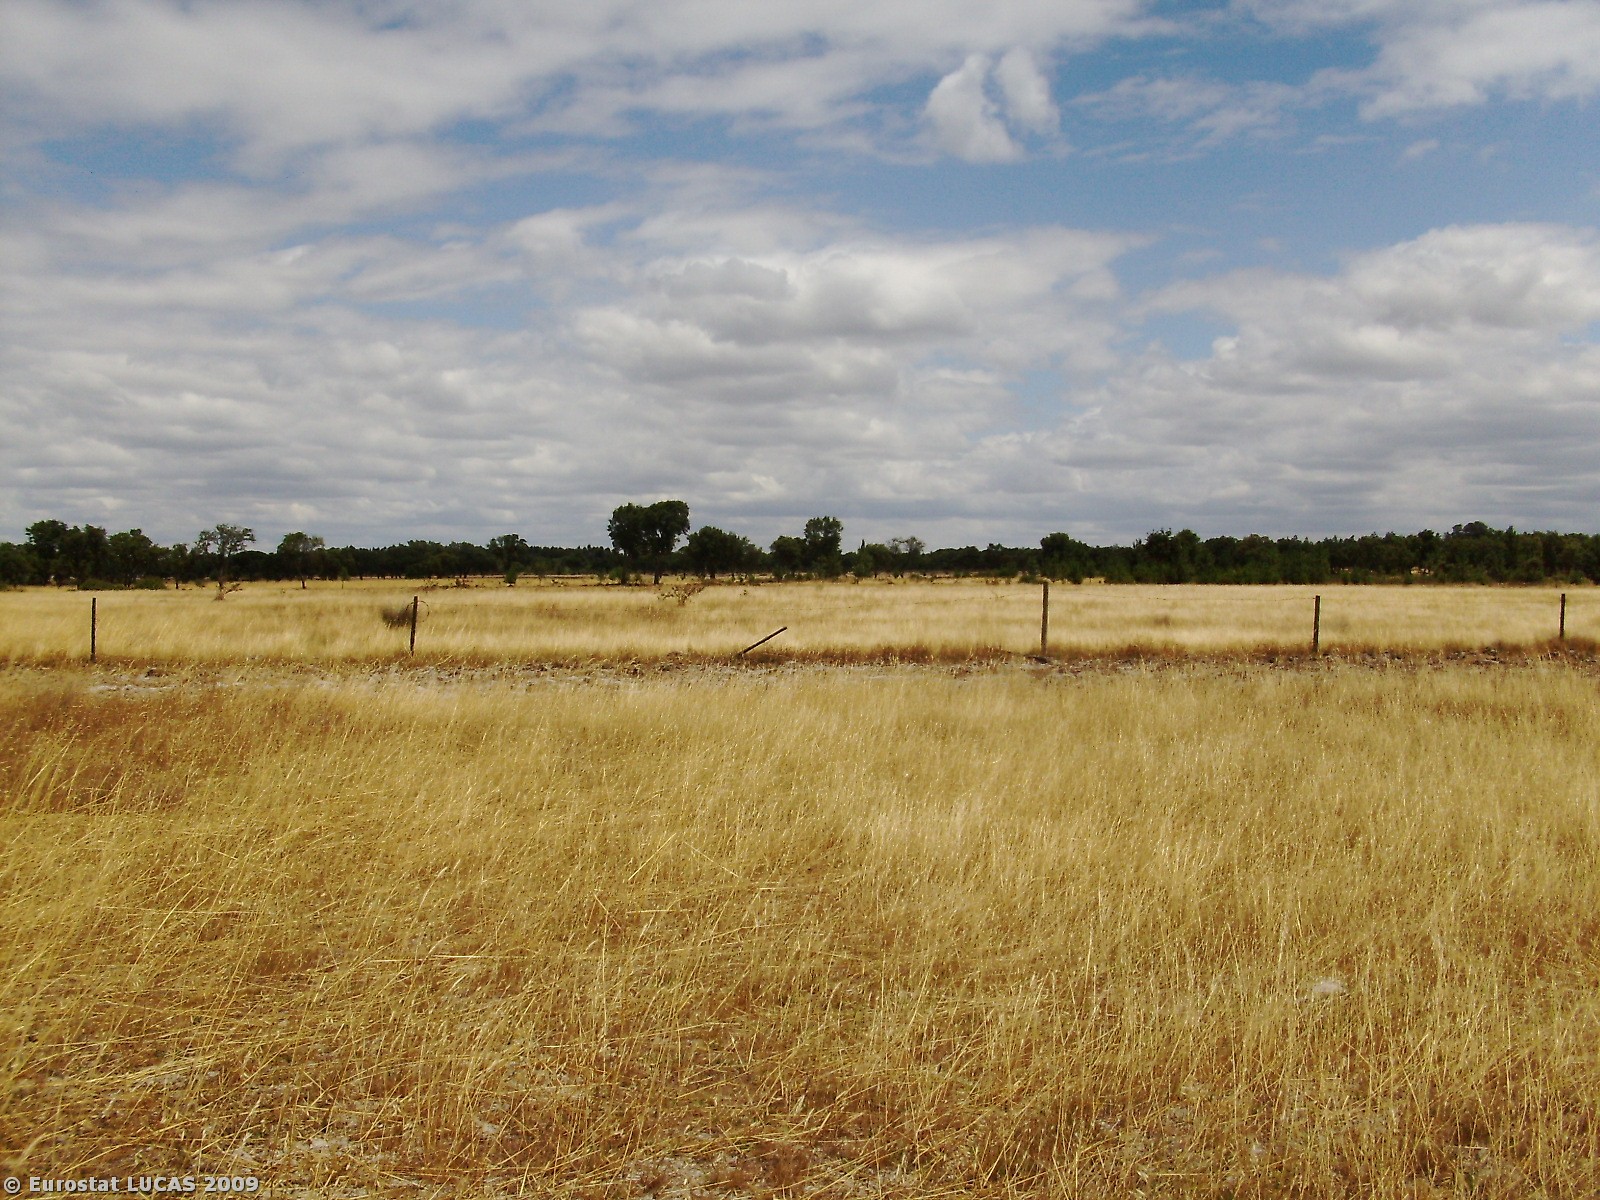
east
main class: Grassland
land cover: Grassland without tree/shrub cover
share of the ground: > 75 %
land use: Agriculture (excluding fallow land and kitchen gardens)
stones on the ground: < 10 %
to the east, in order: Grassland without tree/shrub cover; Rivers and streams; Grassland with sparse tree/shrub cover
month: June
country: PT
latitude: 38.1880
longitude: -8.5321
